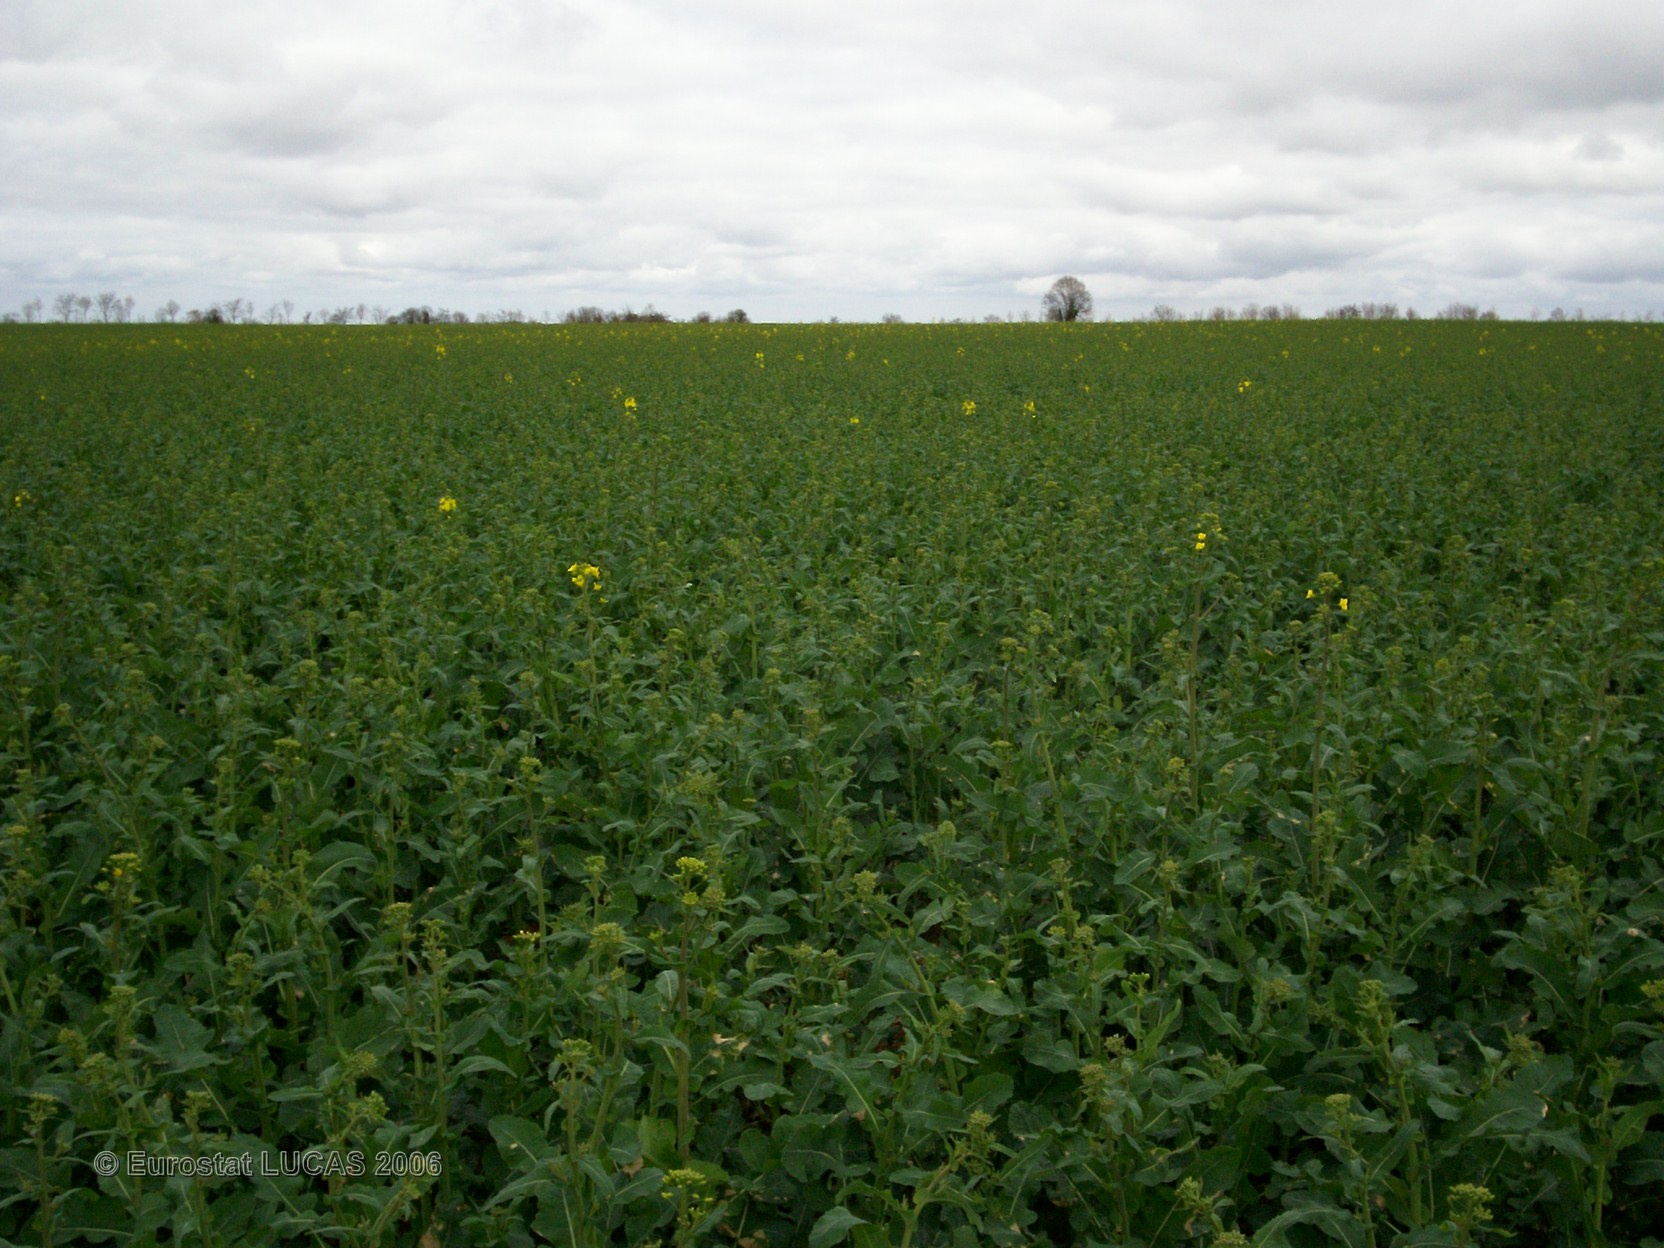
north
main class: Cropland
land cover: Rape and turnip rape
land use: Agriculture (excluding fallow land and kitchen gardens)
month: April
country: FR
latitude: 46.2738
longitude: -0.2616
